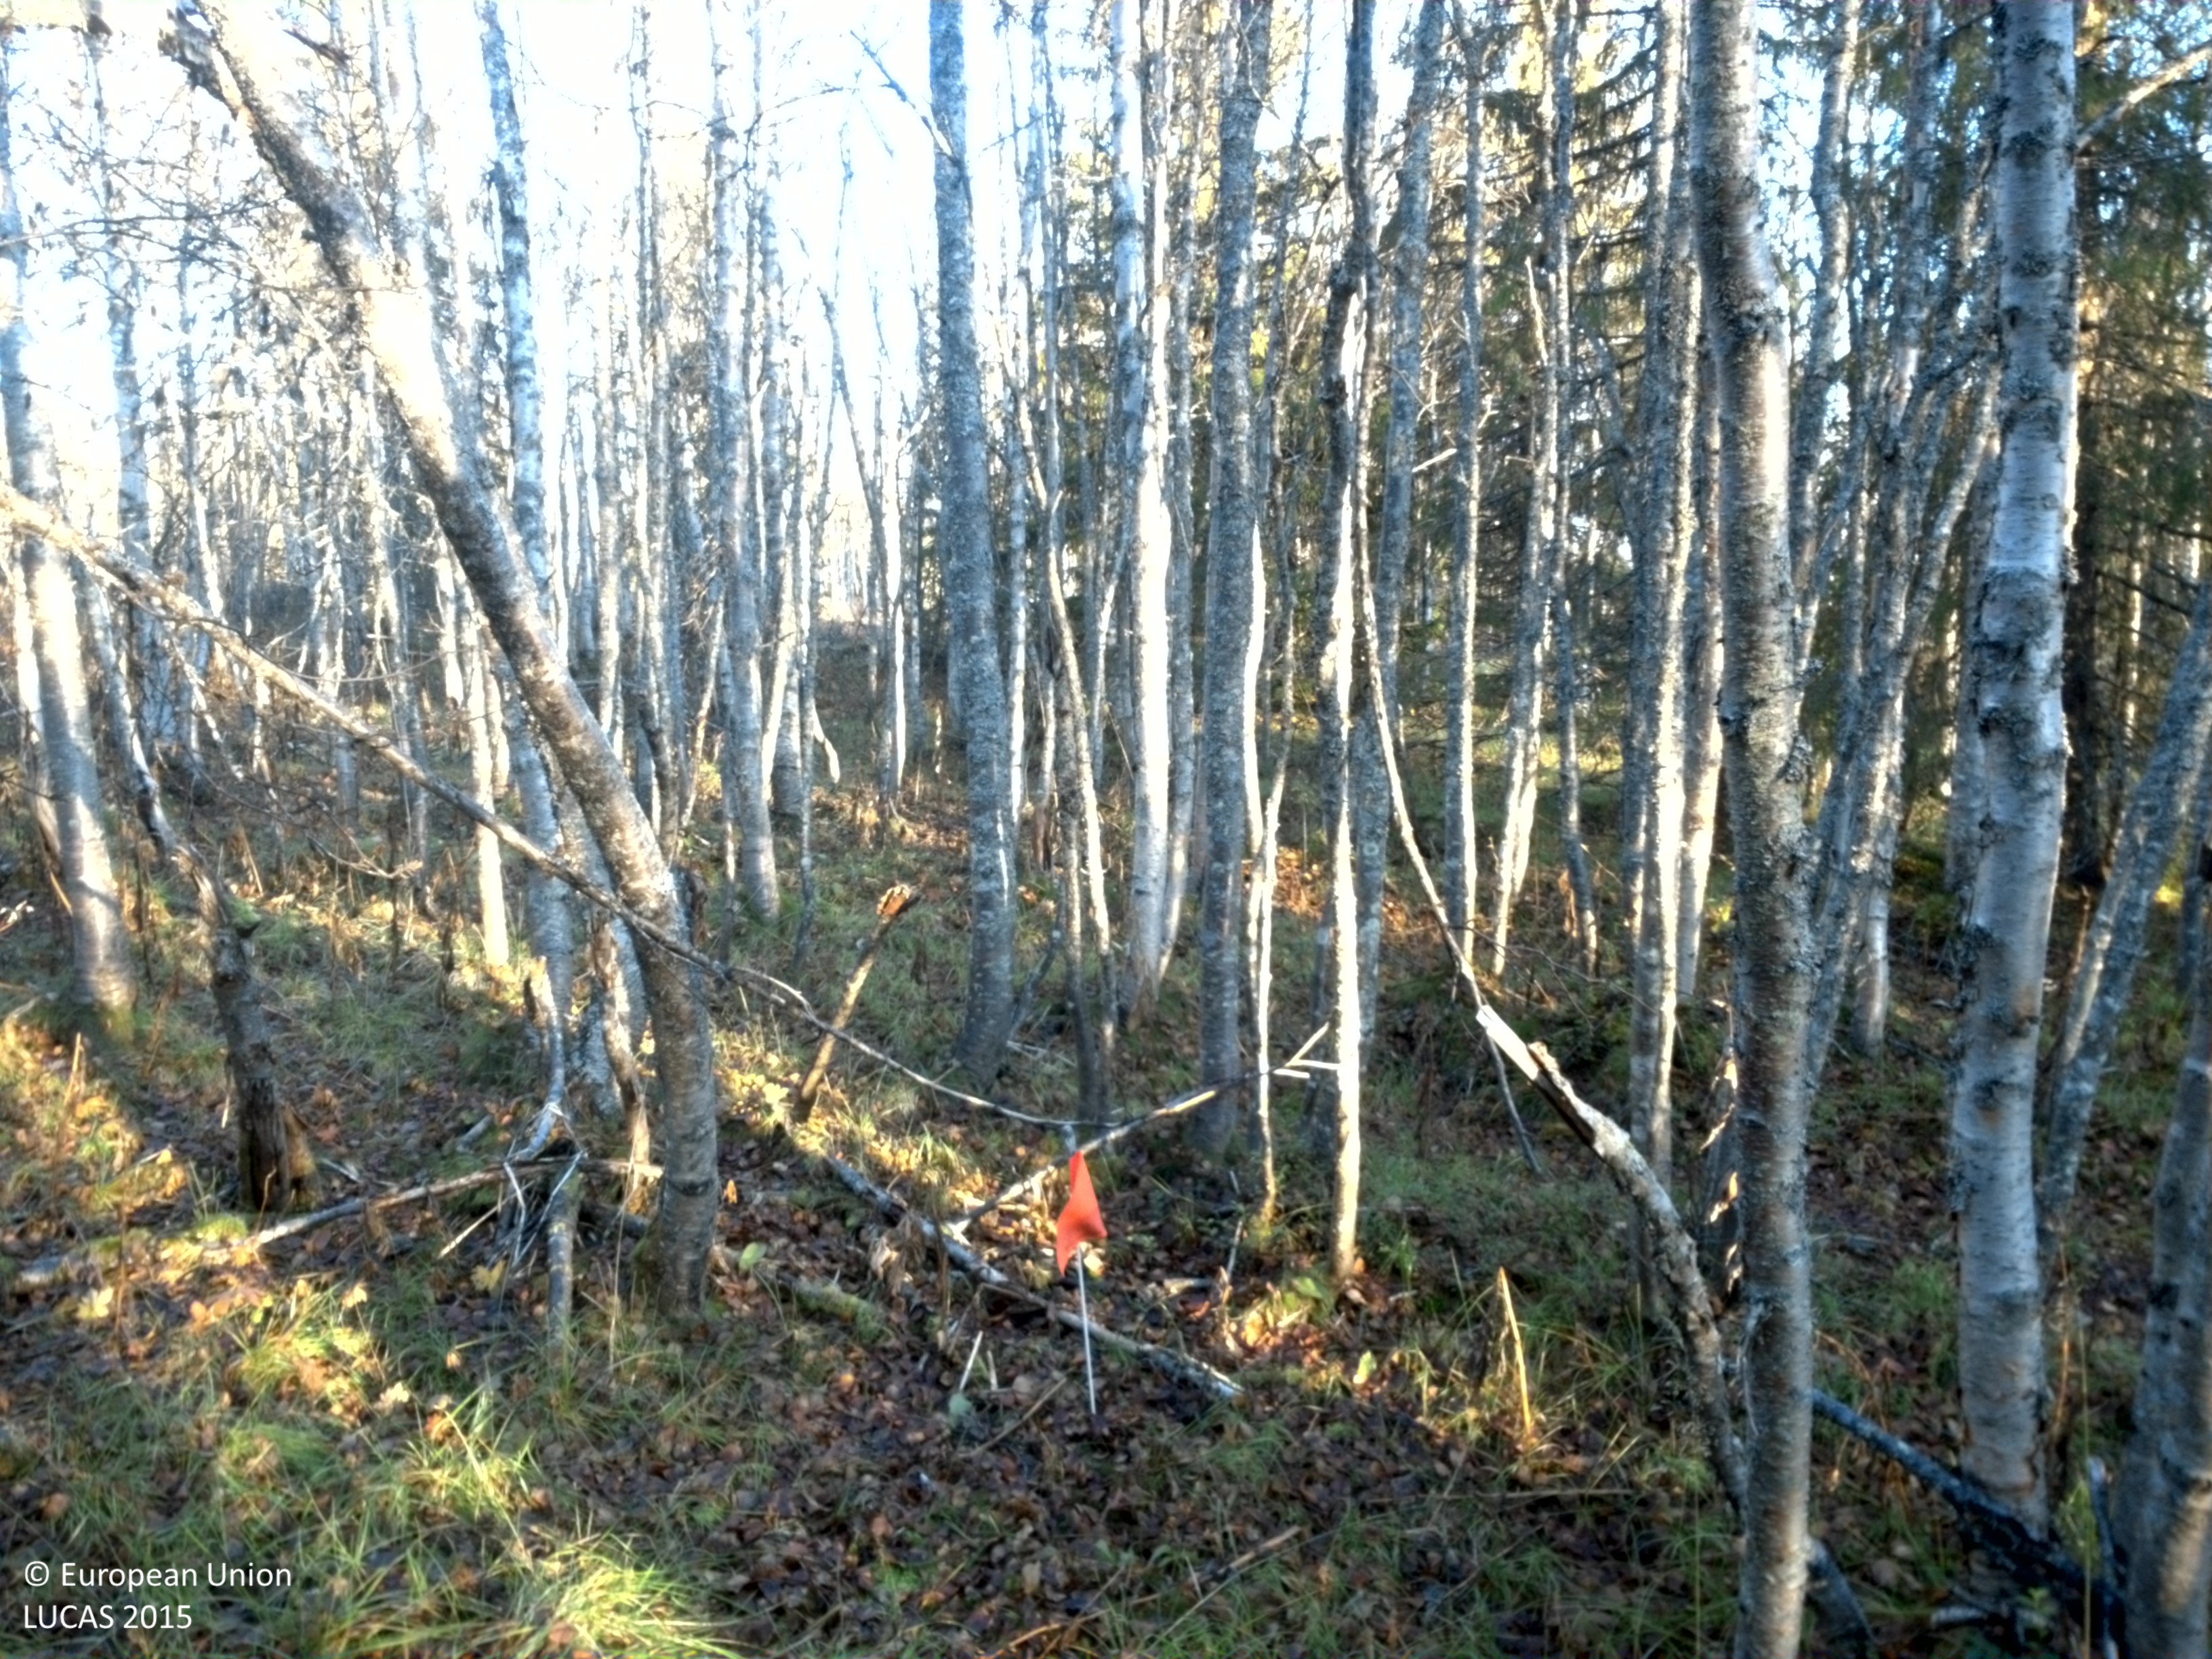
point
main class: Woodland
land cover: Broadleaved woodland
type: non-riverine alder, birch or aspen forest
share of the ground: 50 - 75 %
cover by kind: broadleaved forest trees 50 %, herbaceous plants 30 %, coniferous forest trees 10 %, shrubs 5 %, lichens and mosses 5 %
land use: Forestry
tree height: > 5 m
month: October
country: SE
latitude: 64.7347
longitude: 17.3781
